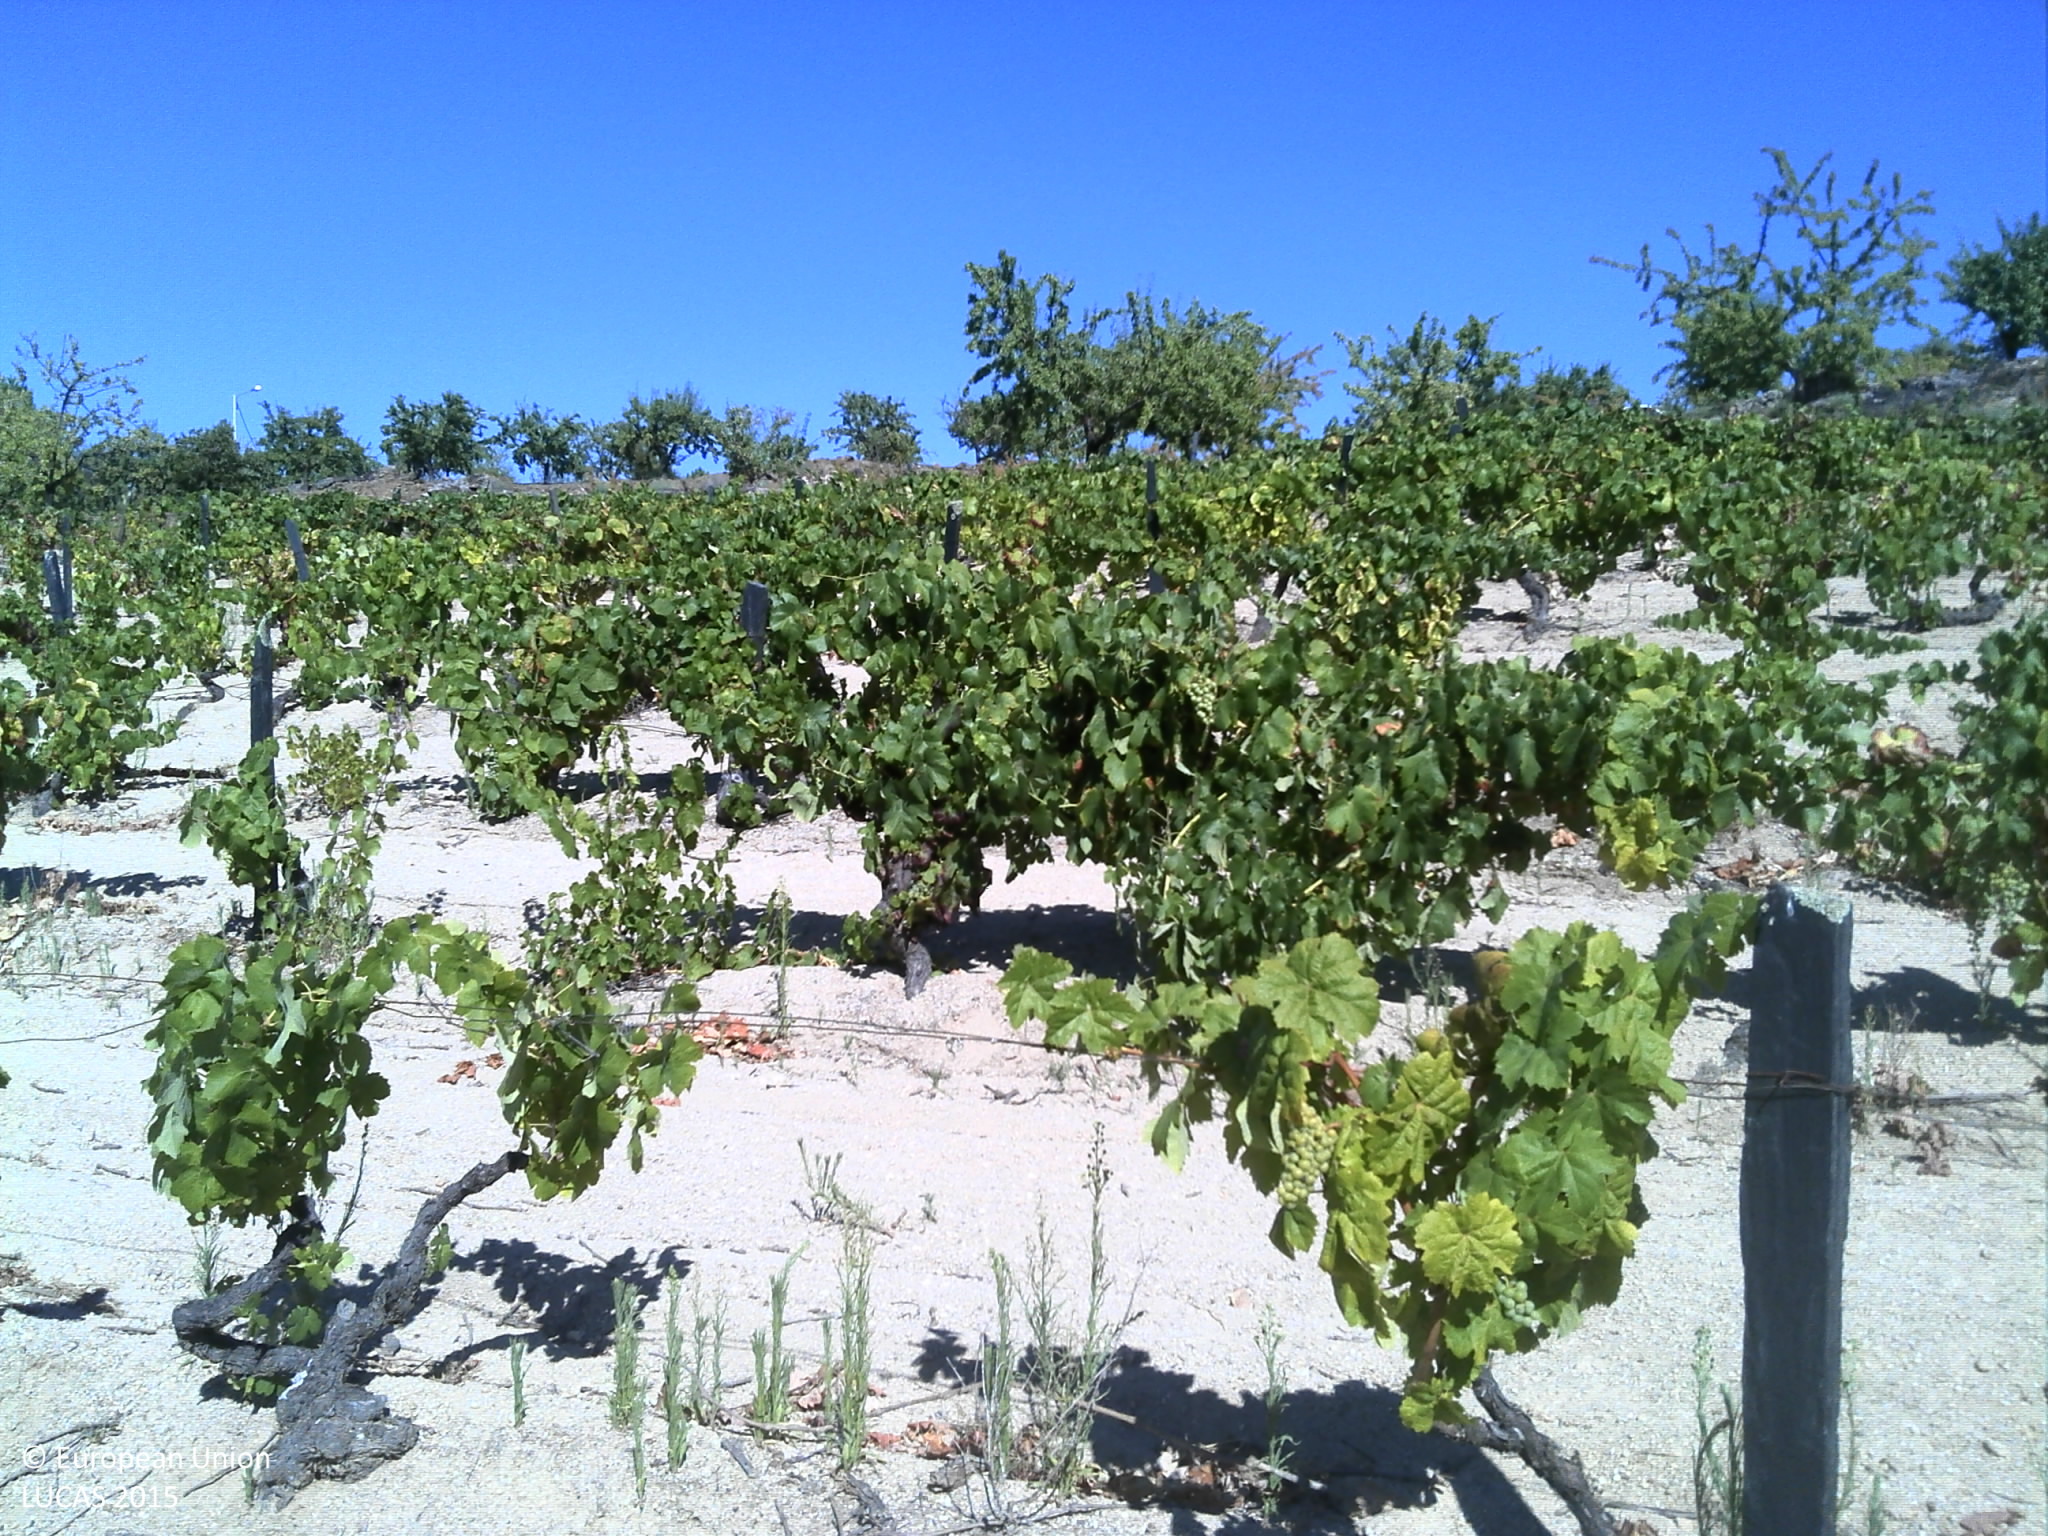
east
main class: Cropland
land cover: Vineyards
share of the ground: 10 - 25 %
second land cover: Other bare soil
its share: > 75 %
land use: Agriculture (excluding fallow land and kitchen gardens)
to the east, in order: Vineyards; Other bare soil; Vineyards; Nuts trees; Tracks; Nuts trees; Rocks and stones; Nuts trees; Fences; Tracks; Shrubland with sparse tree cover; Tracks; Nuts trees; Grassland without tree/shrub cover; Dry stone walls; Electric lines; Paved roads, cycling and walking lanes; Dry stone walls; Vineyards
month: July
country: PT
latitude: 41.2841
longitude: -7.1777
